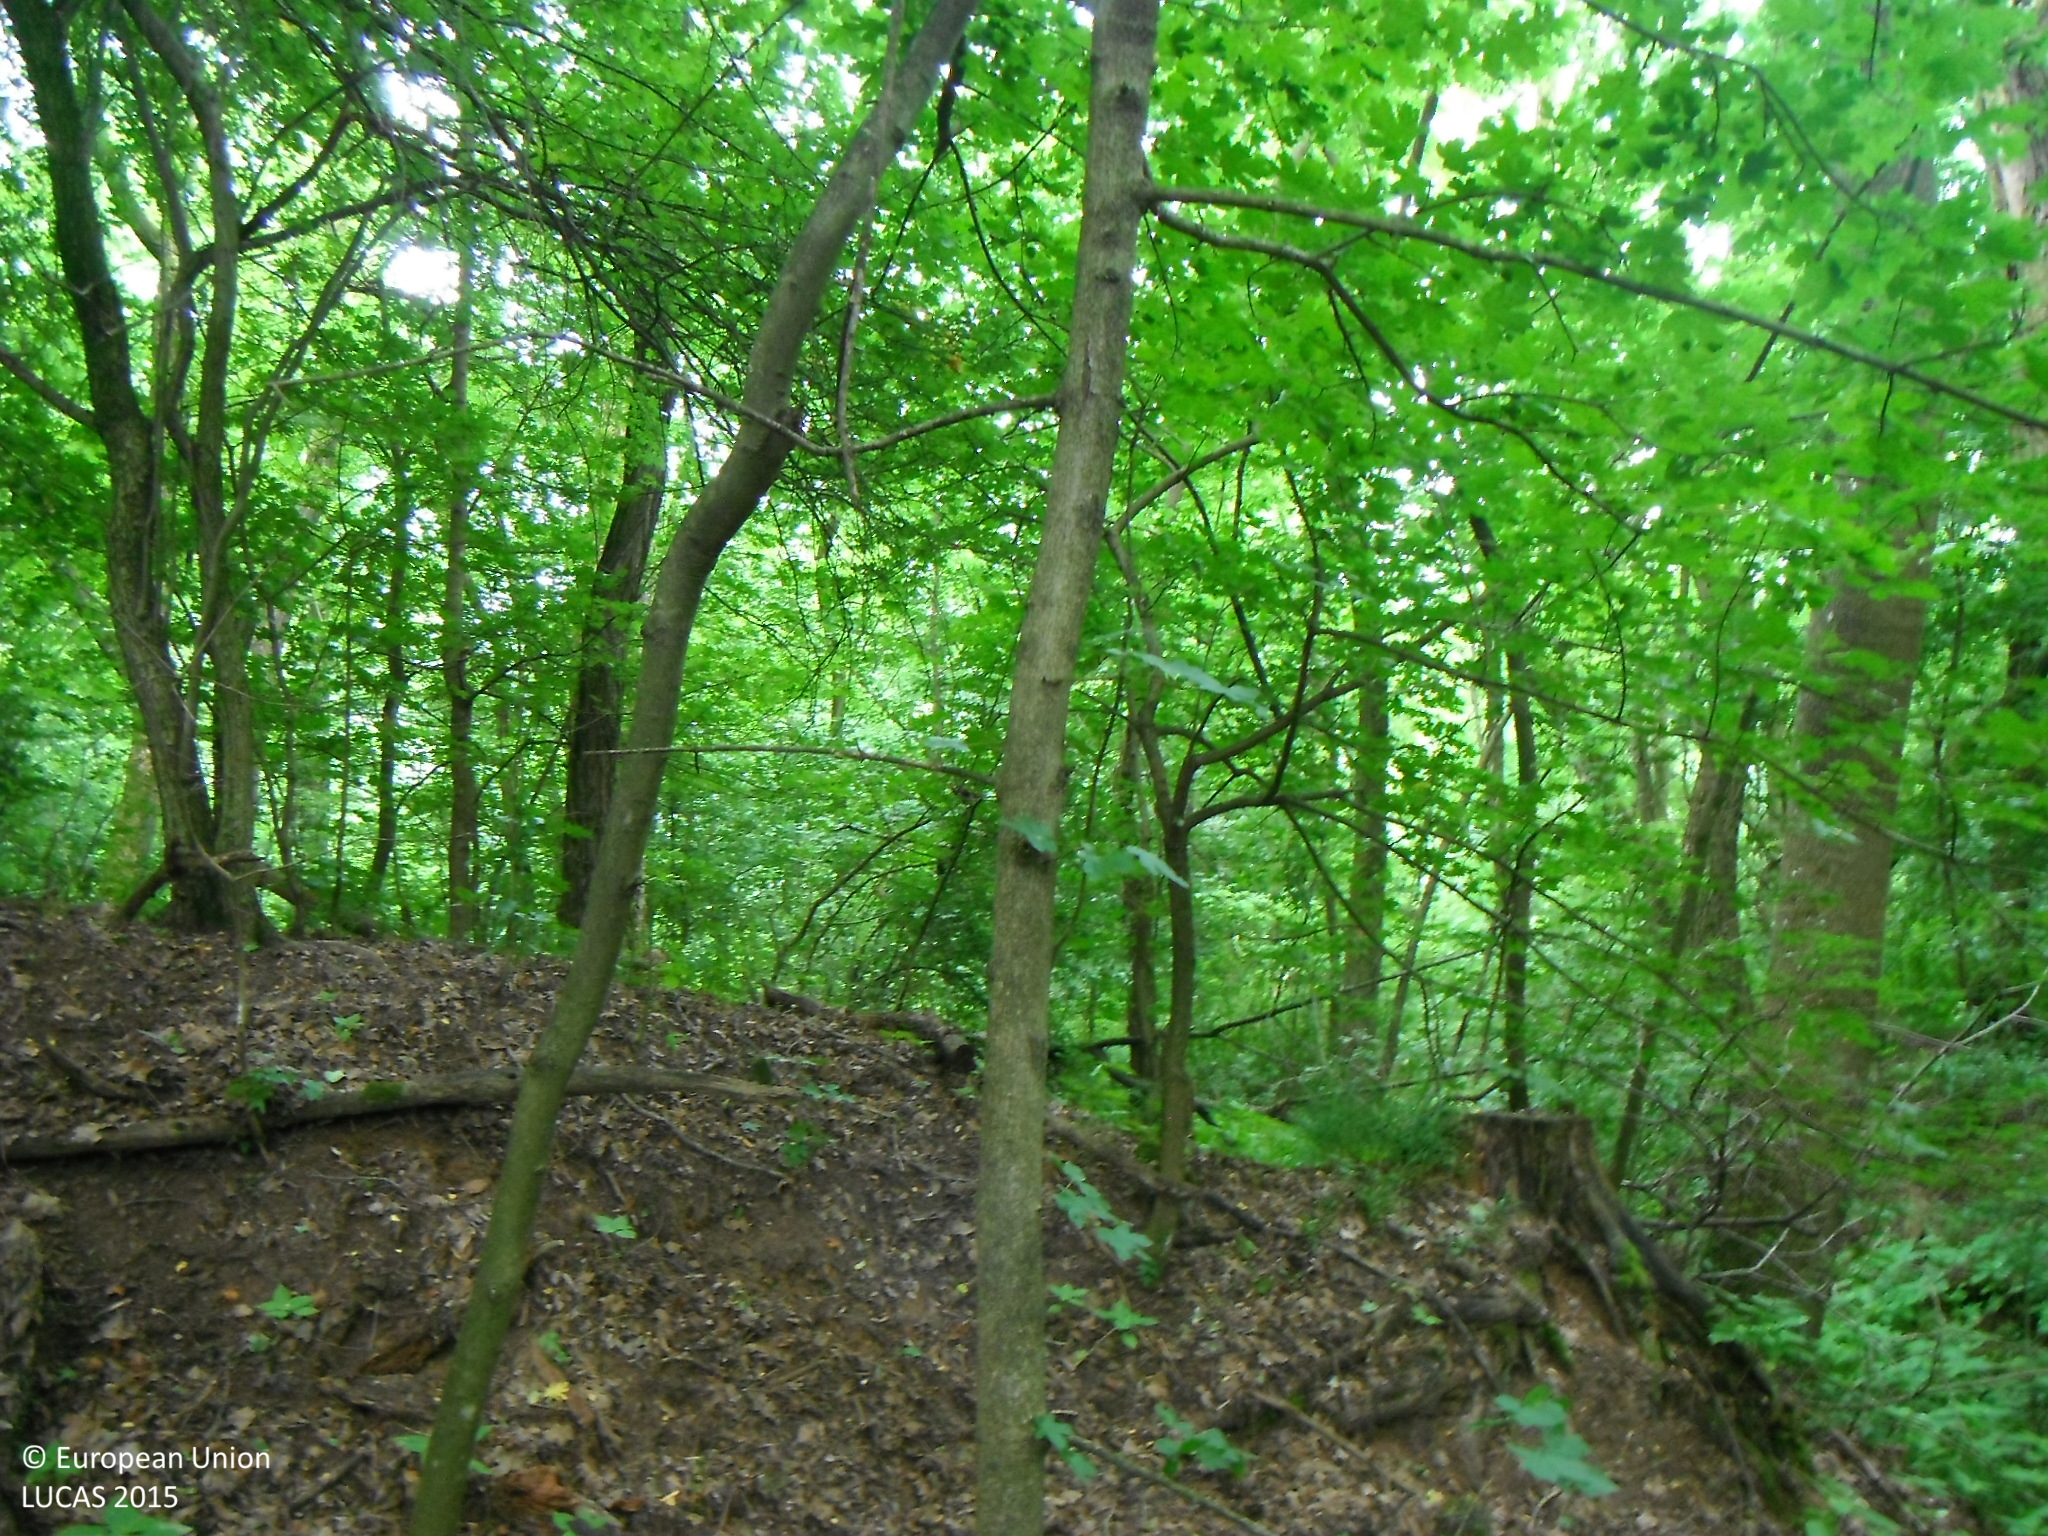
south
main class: Woodland
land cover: Broadleaved woodland
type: mesophytic deciduous forest
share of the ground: > 75 %
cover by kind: broadleaved forest trees 100 %
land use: Forestry
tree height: > 5 m
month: June
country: SK
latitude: 48.2773
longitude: 19.3610
